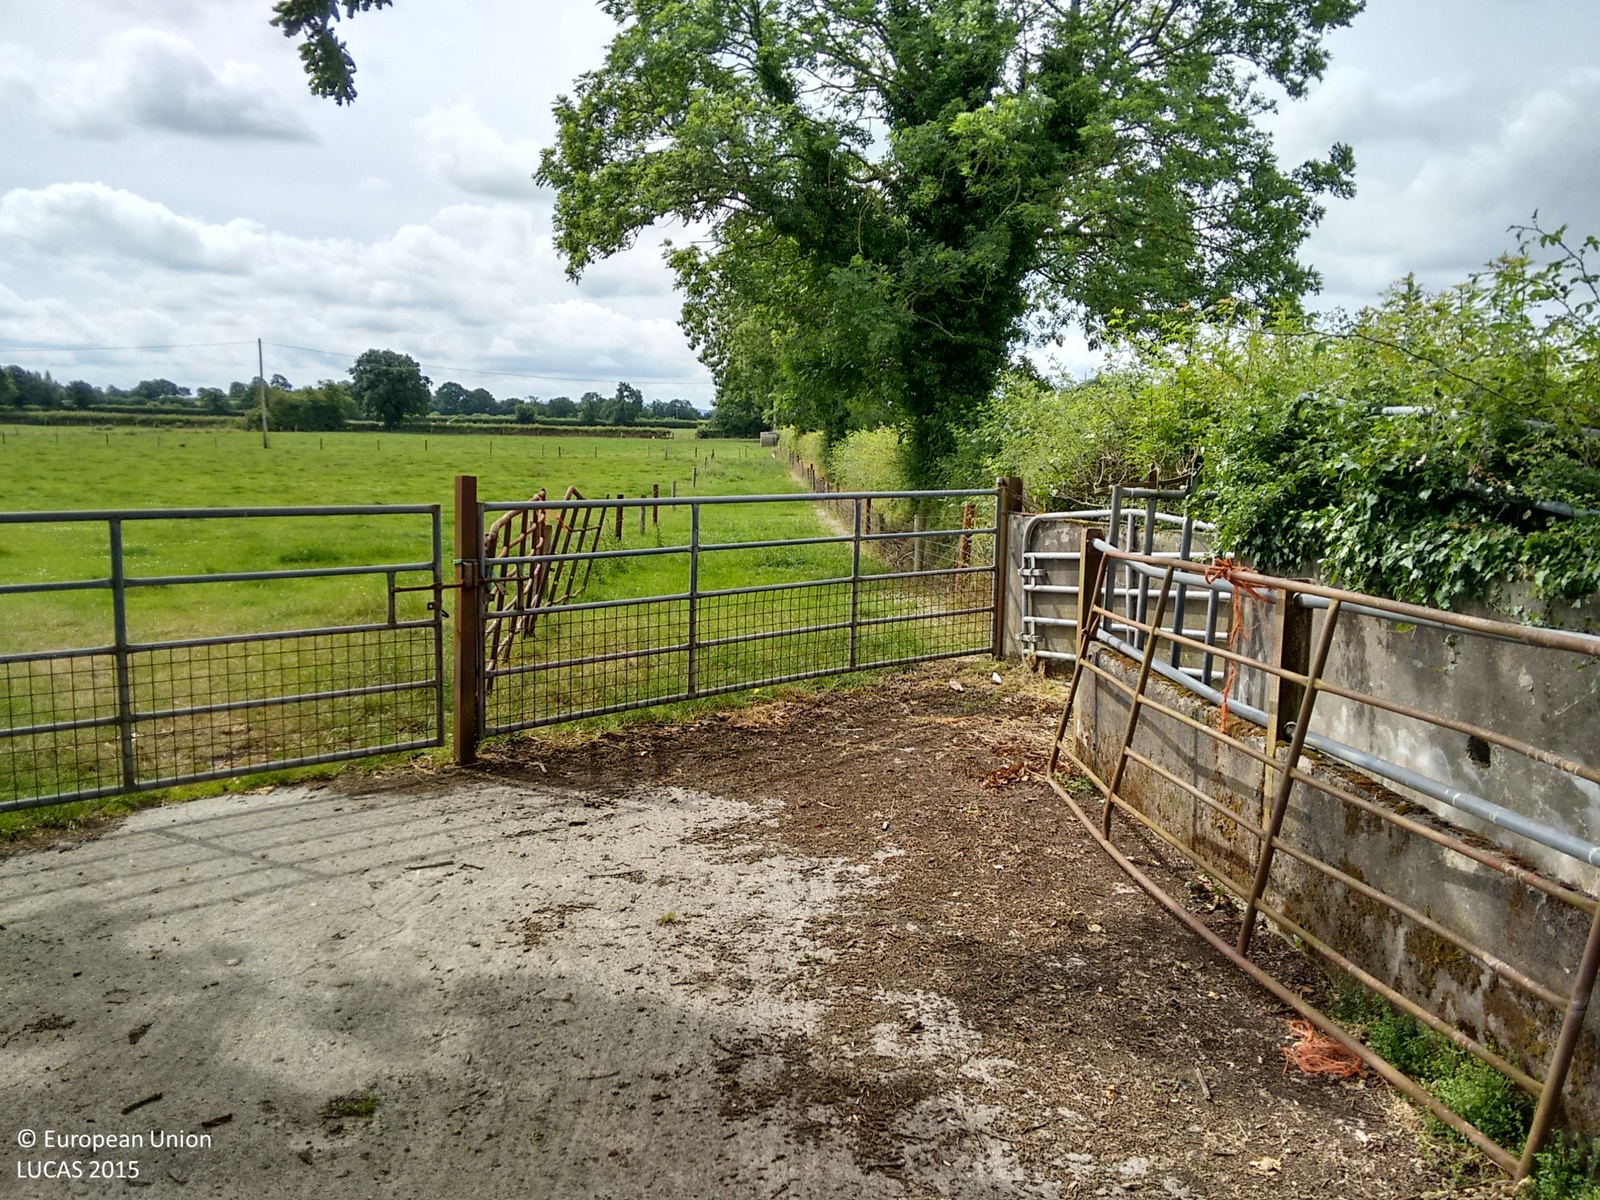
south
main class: Grassland
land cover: Grassland without tree/shrub cover
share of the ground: > 75 %
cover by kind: herbaceous plants 100 %
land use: Agriculture (excluding fallow land and kitchen gardens)
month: July
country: IE
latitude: 52.5735
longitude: -7.3744
